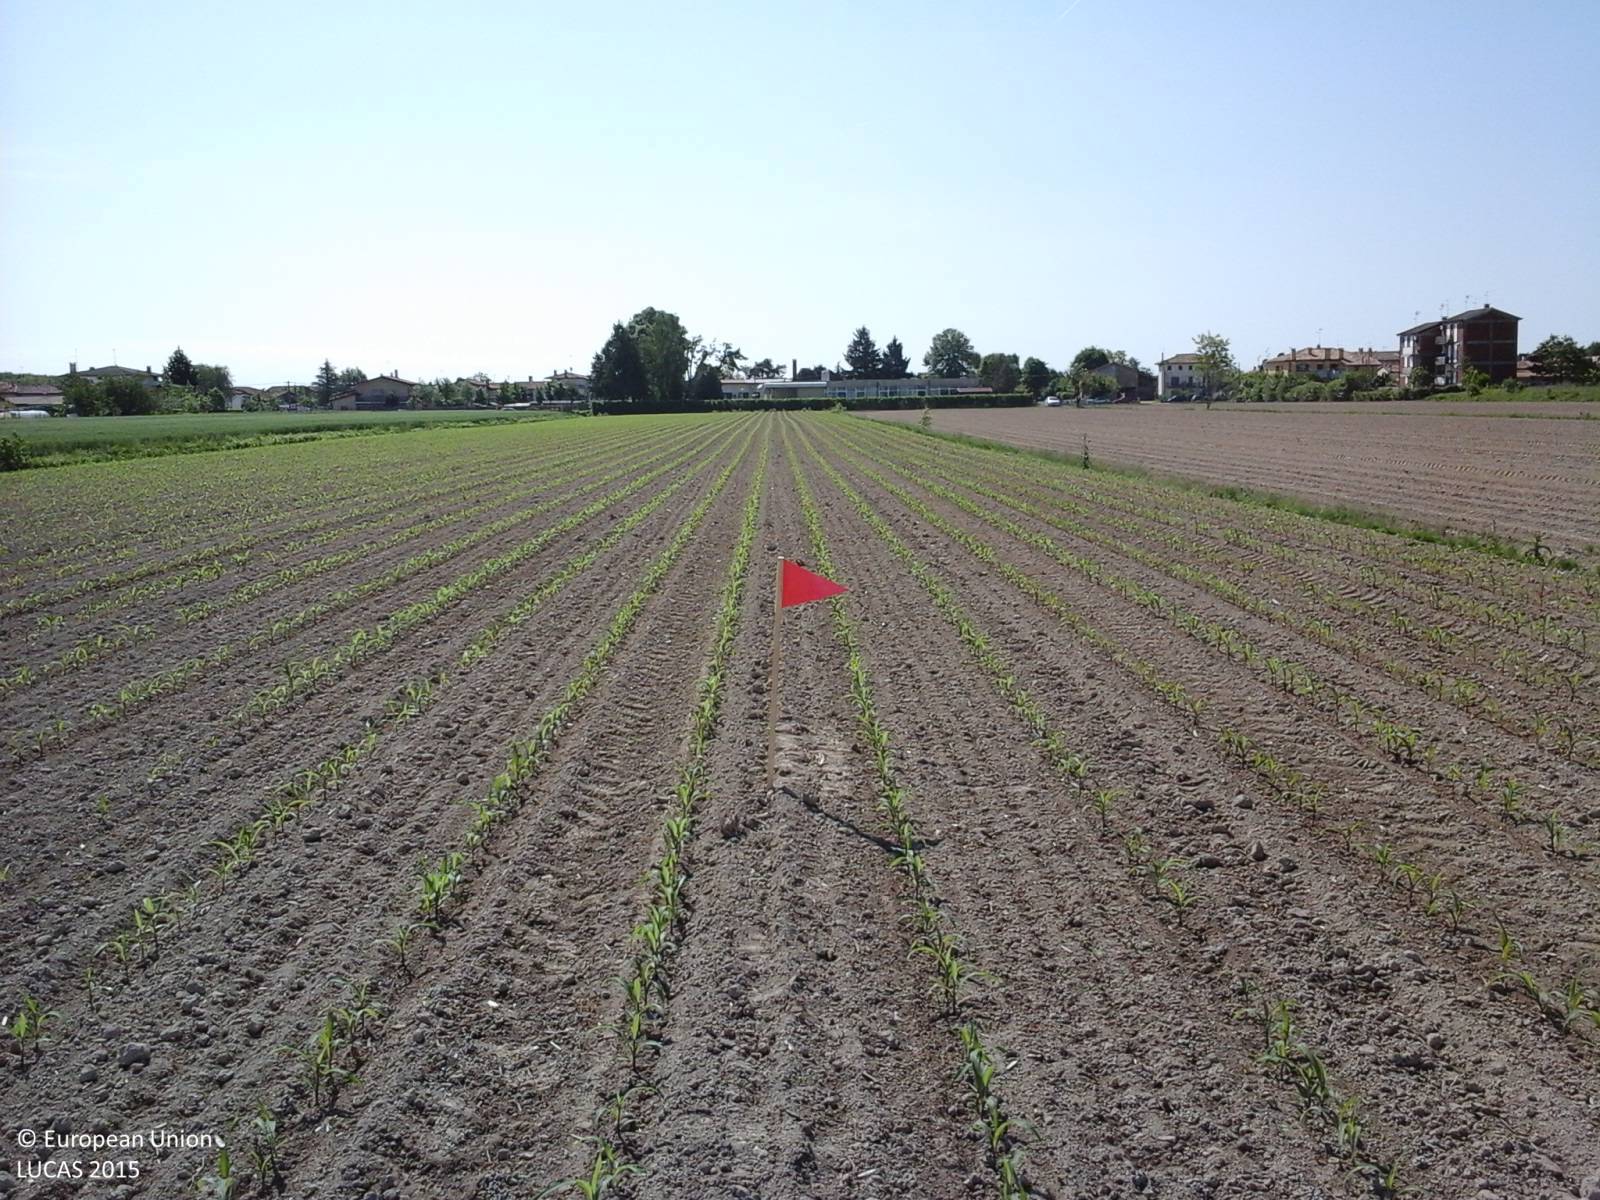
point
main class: Cropland
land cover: Maize
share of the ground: < 10 %
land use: Agriculture (excluding fallow land and kitchen gardens)
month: May
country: IT
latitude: 45.7498
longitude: 13.0169
